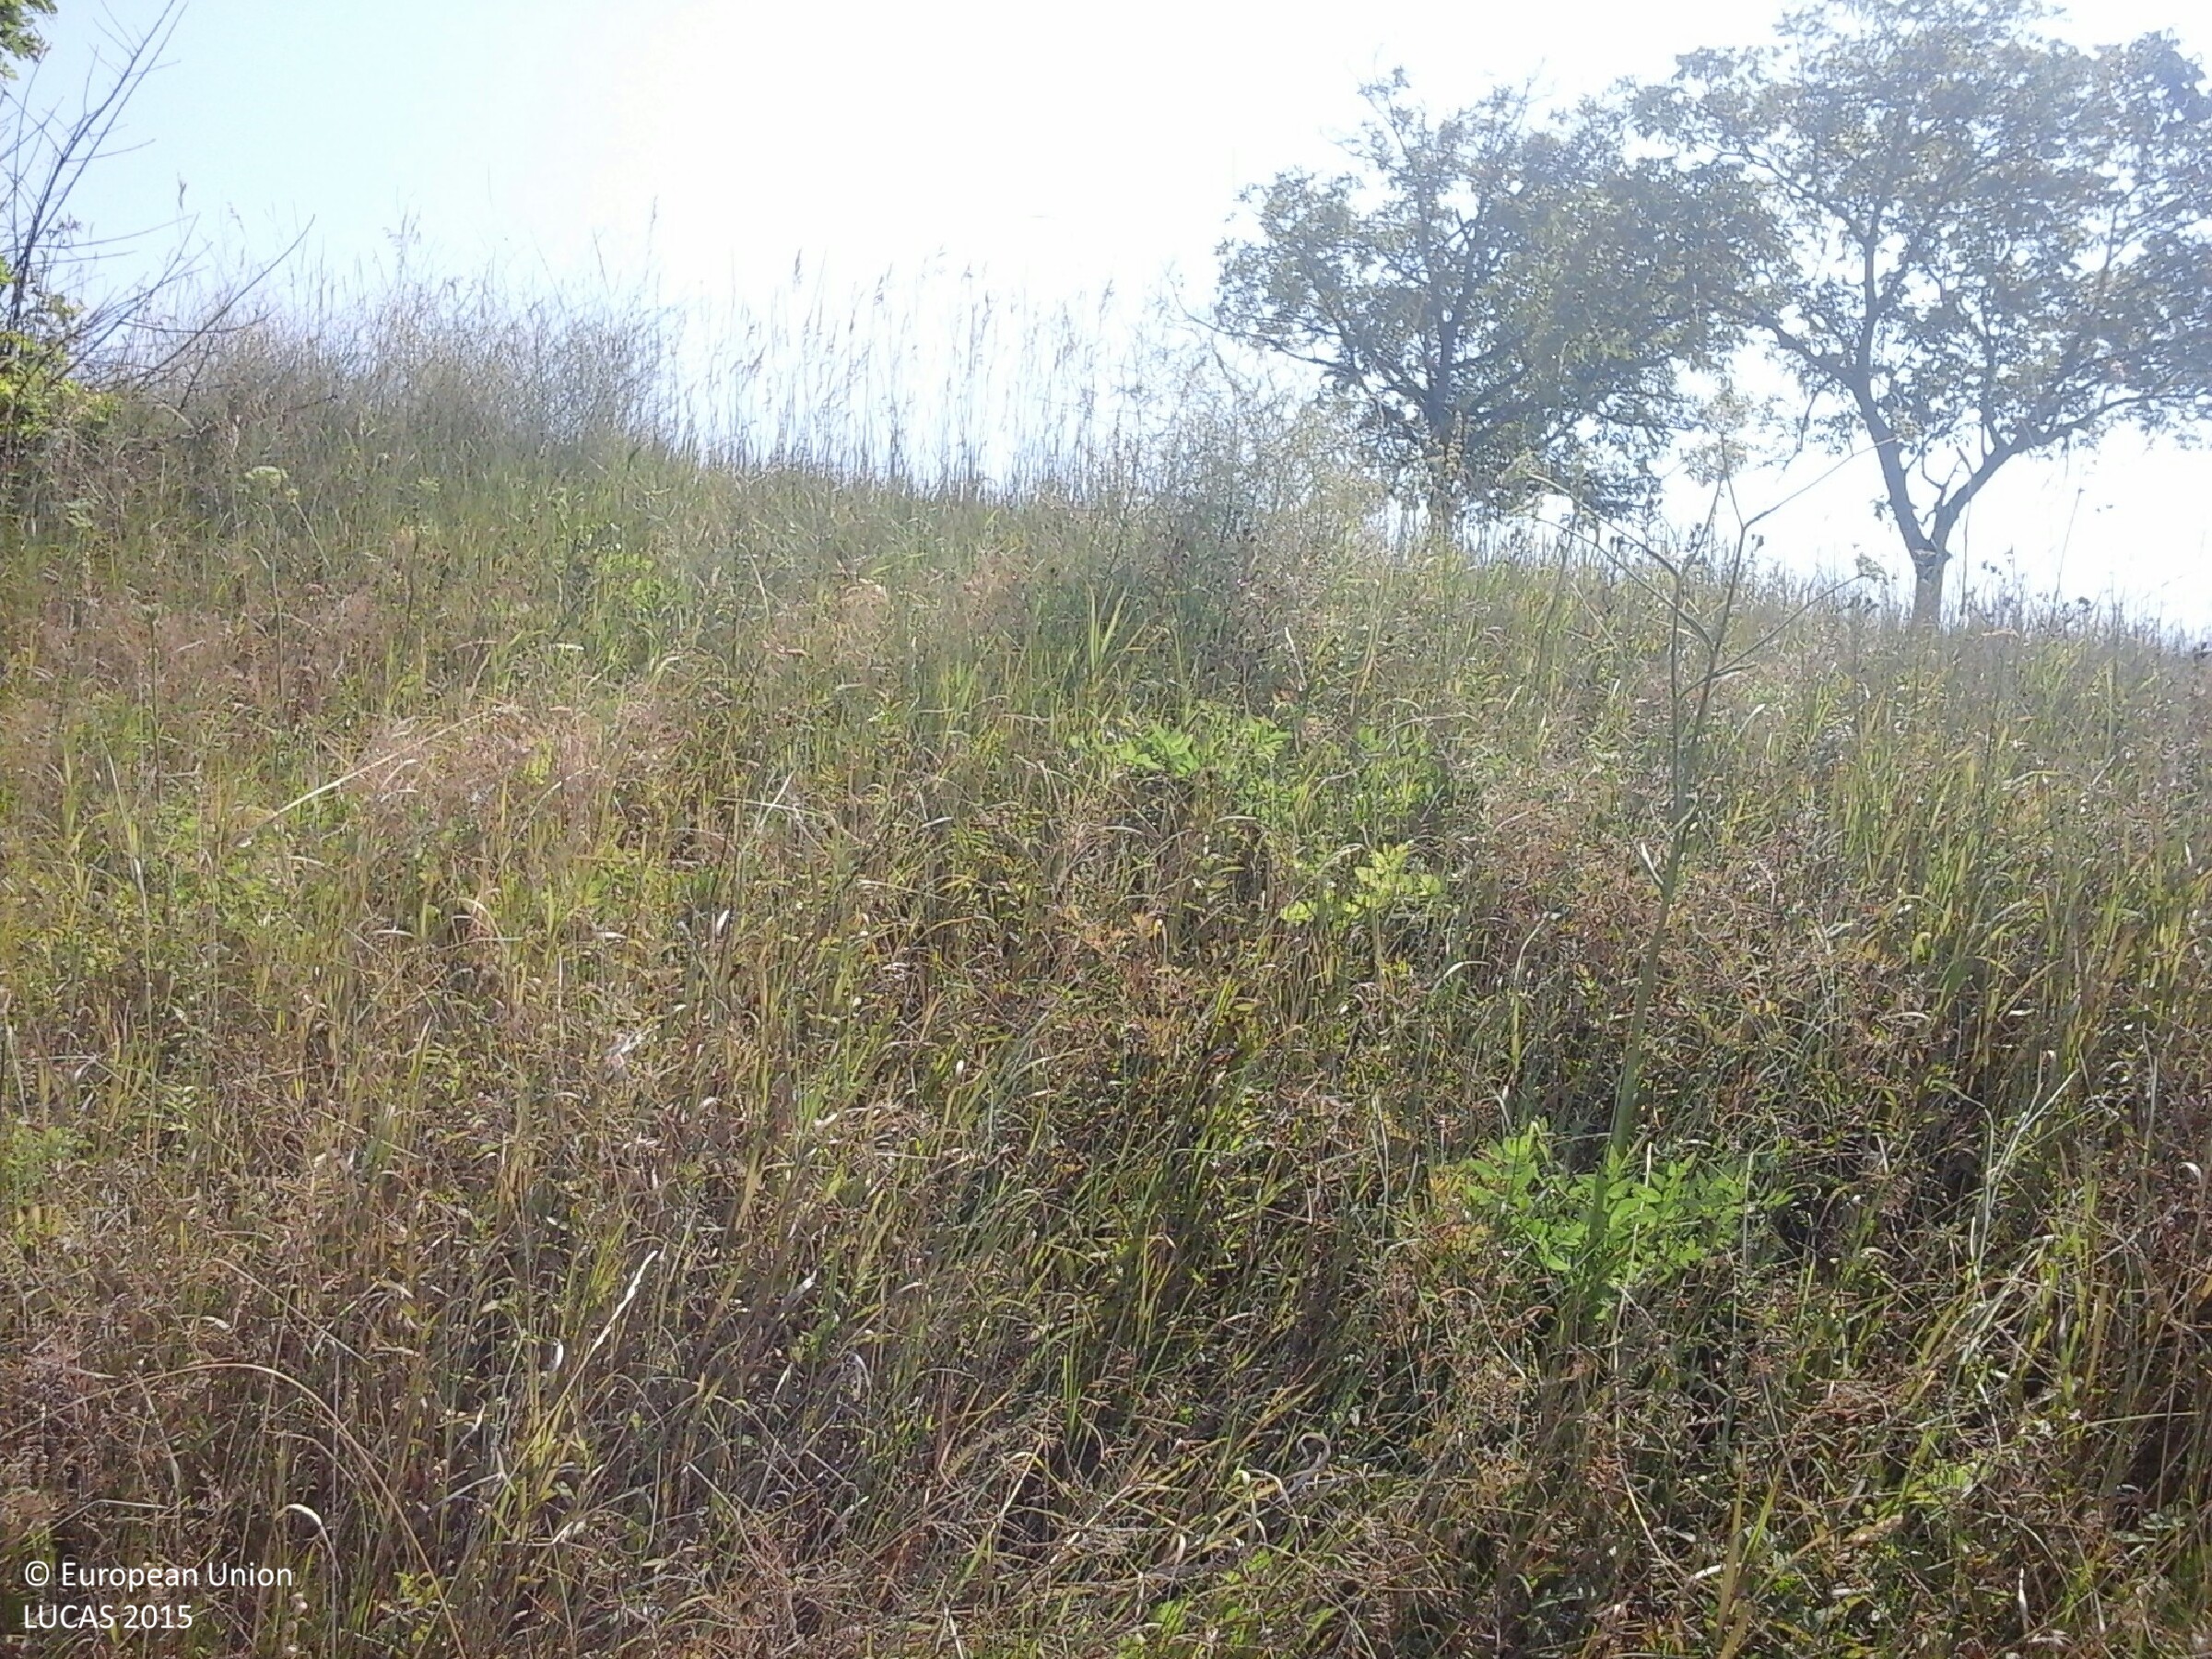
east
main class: Grassland
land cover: Grassland with sparse tree/shrub cover
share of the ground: > 75 %
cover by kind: herbaceous plants 95 %, broadleaved forest trees 5 %
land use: Abandoned areas
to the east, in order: Grassland with sparse tree/shrub cover; Grassland without tree/shrub cover
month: July
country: HU
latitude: 48.1909
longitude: 20.7037
